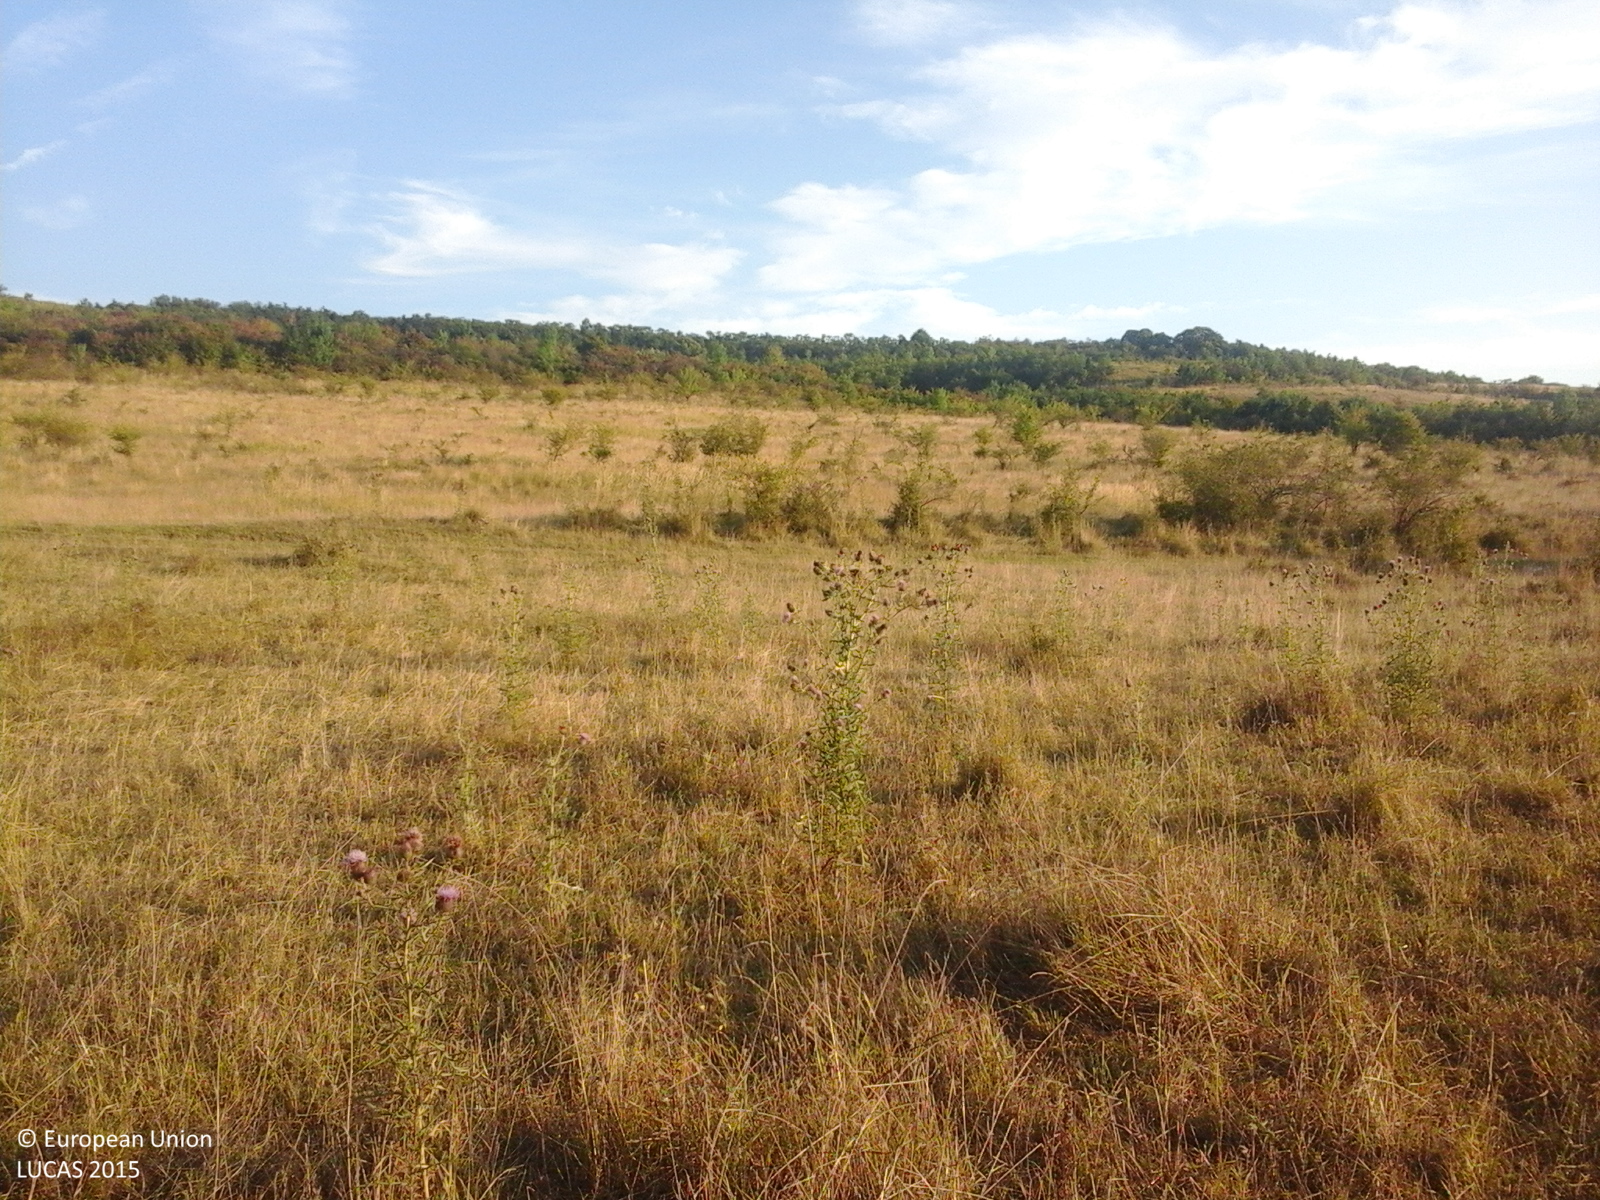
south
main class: Grassland
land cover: Grassland without tree/shrub cover
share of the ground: > 75 %
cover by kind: herbaceous plants 100 %
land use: Agriculture (excluding fallow land and kitchen gardens)
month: August
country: RO
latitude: 45.8822
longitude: 21.5936
